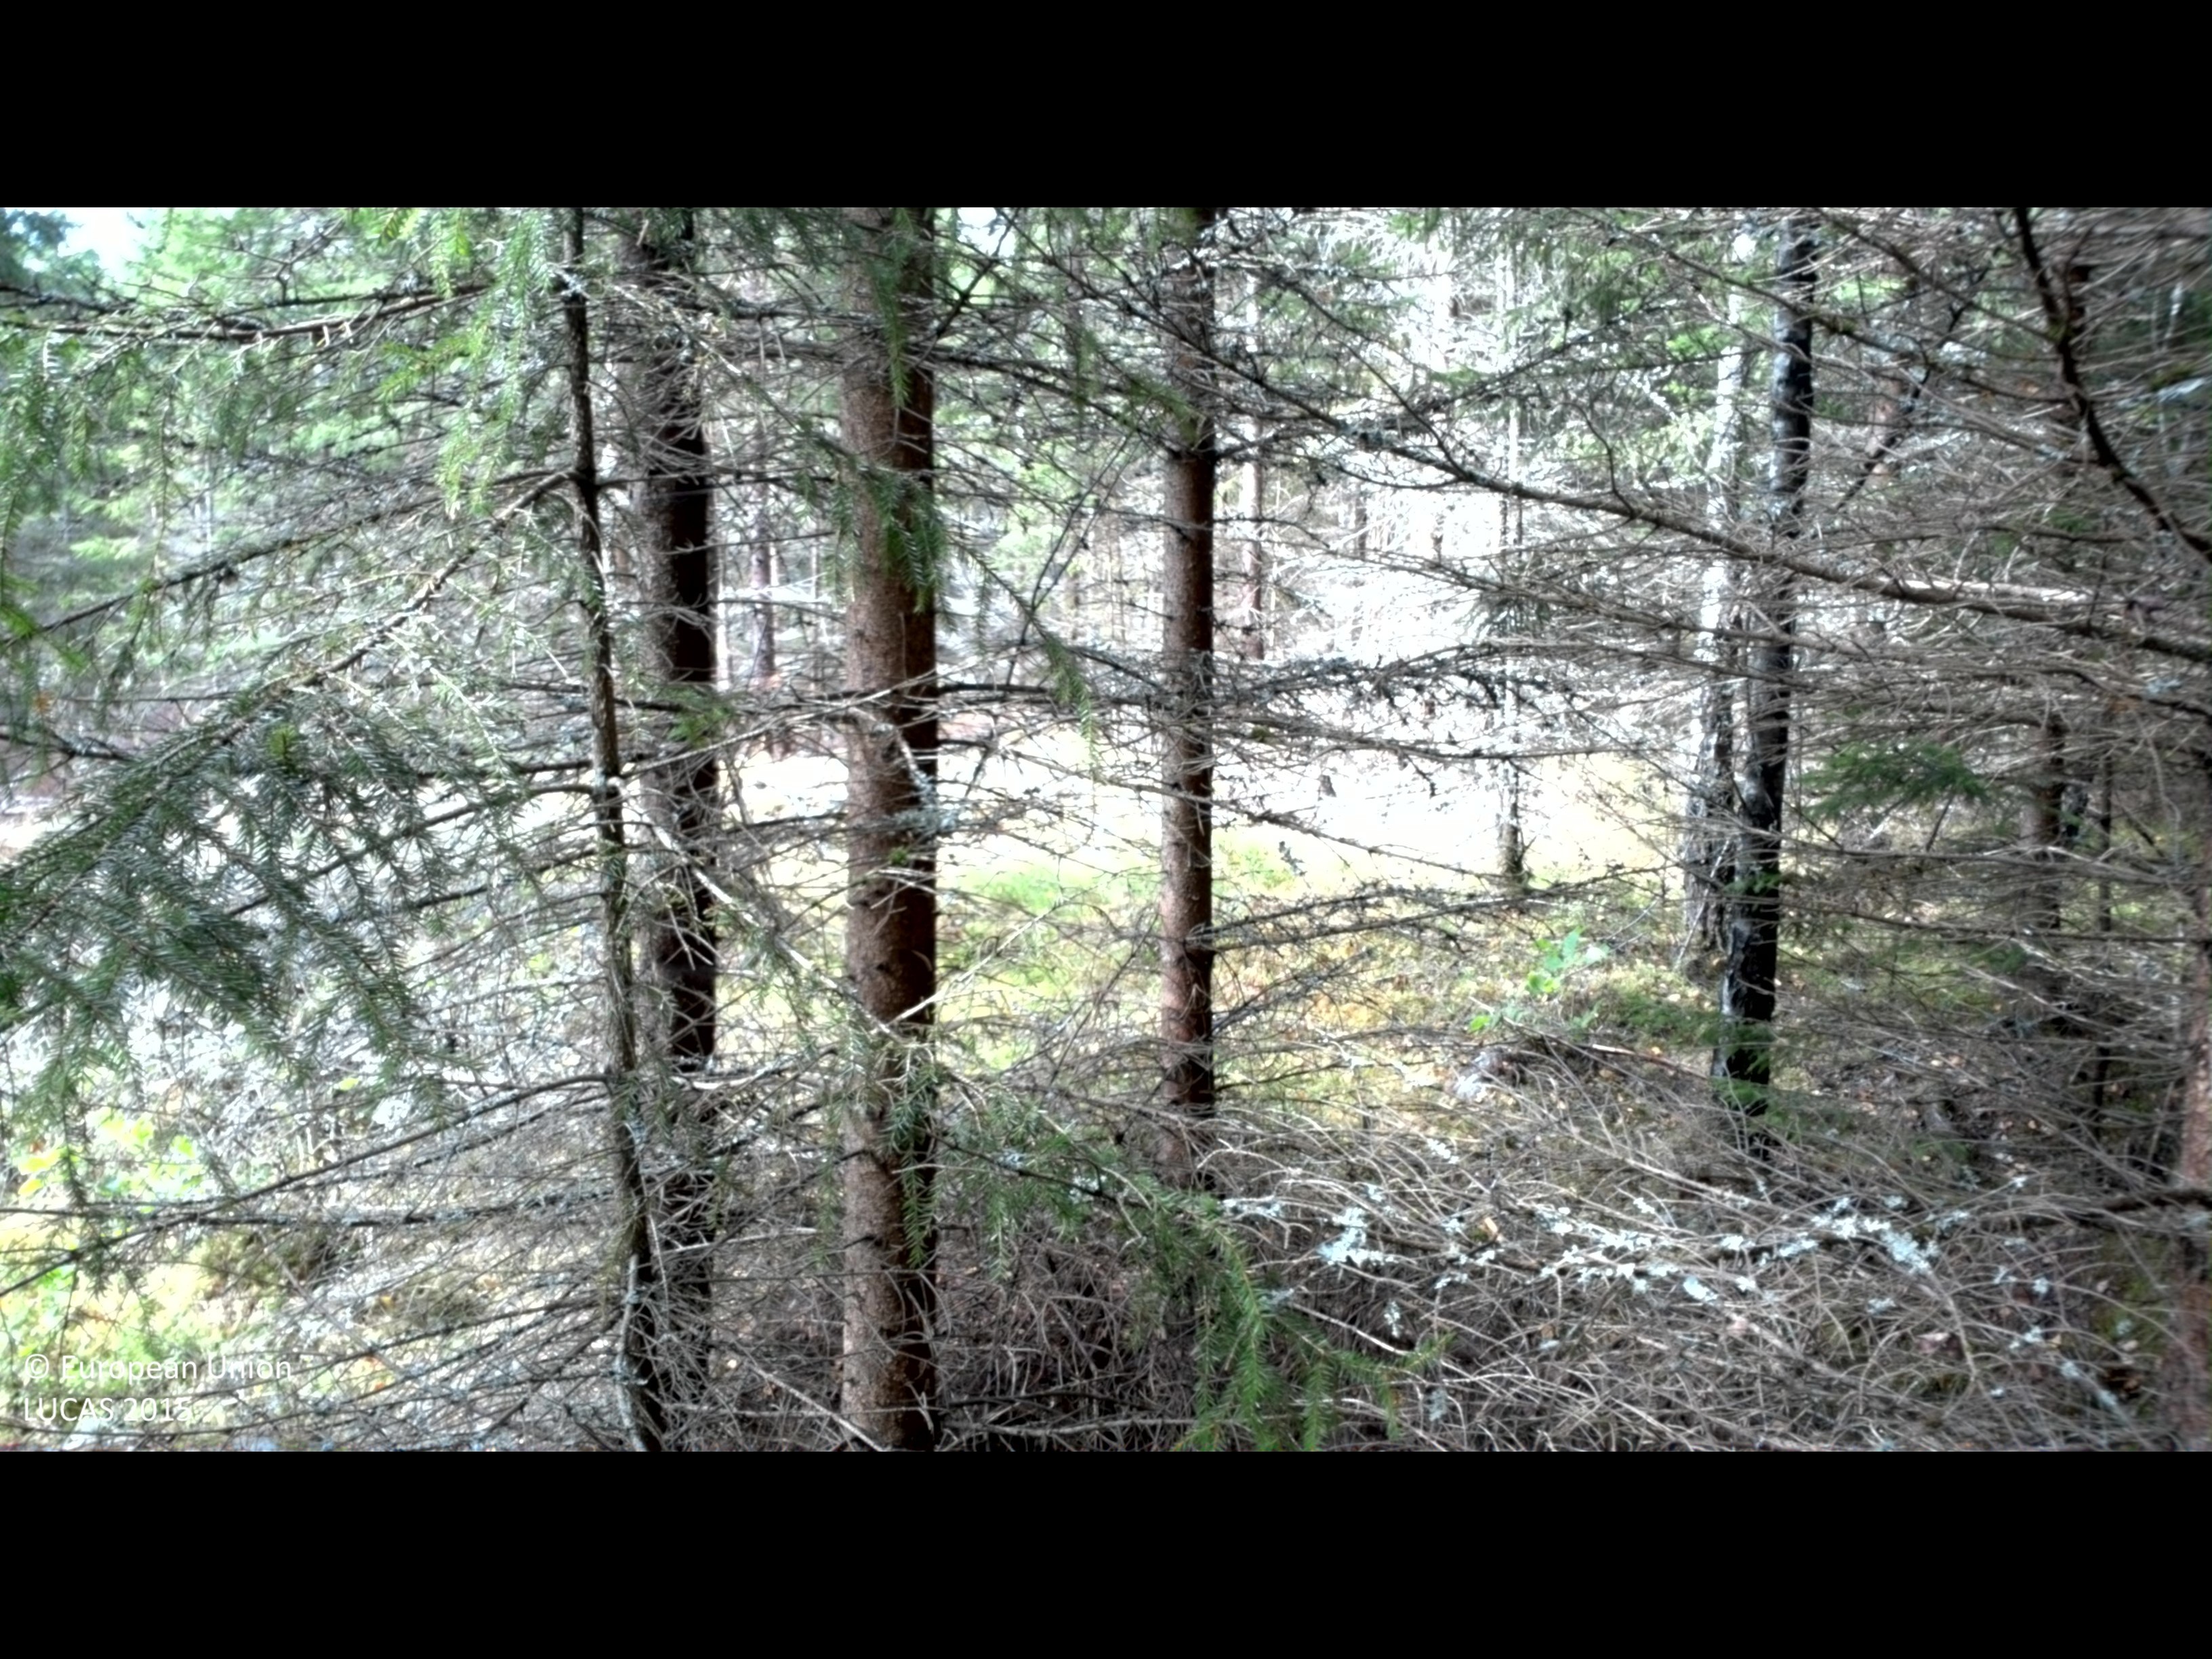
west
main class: Woodland
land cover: Spruce dominated coniferous woodland
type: boreal forest
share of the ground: > 75 %
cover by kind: coniferous forest trees 85 %, broadleaved forest trees 5 %, shrubs 5 %, lichens and mosses 5 %
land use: Forestry
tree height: > 5 m
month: August
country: SE
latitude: 56.3280
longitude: 14.4127
